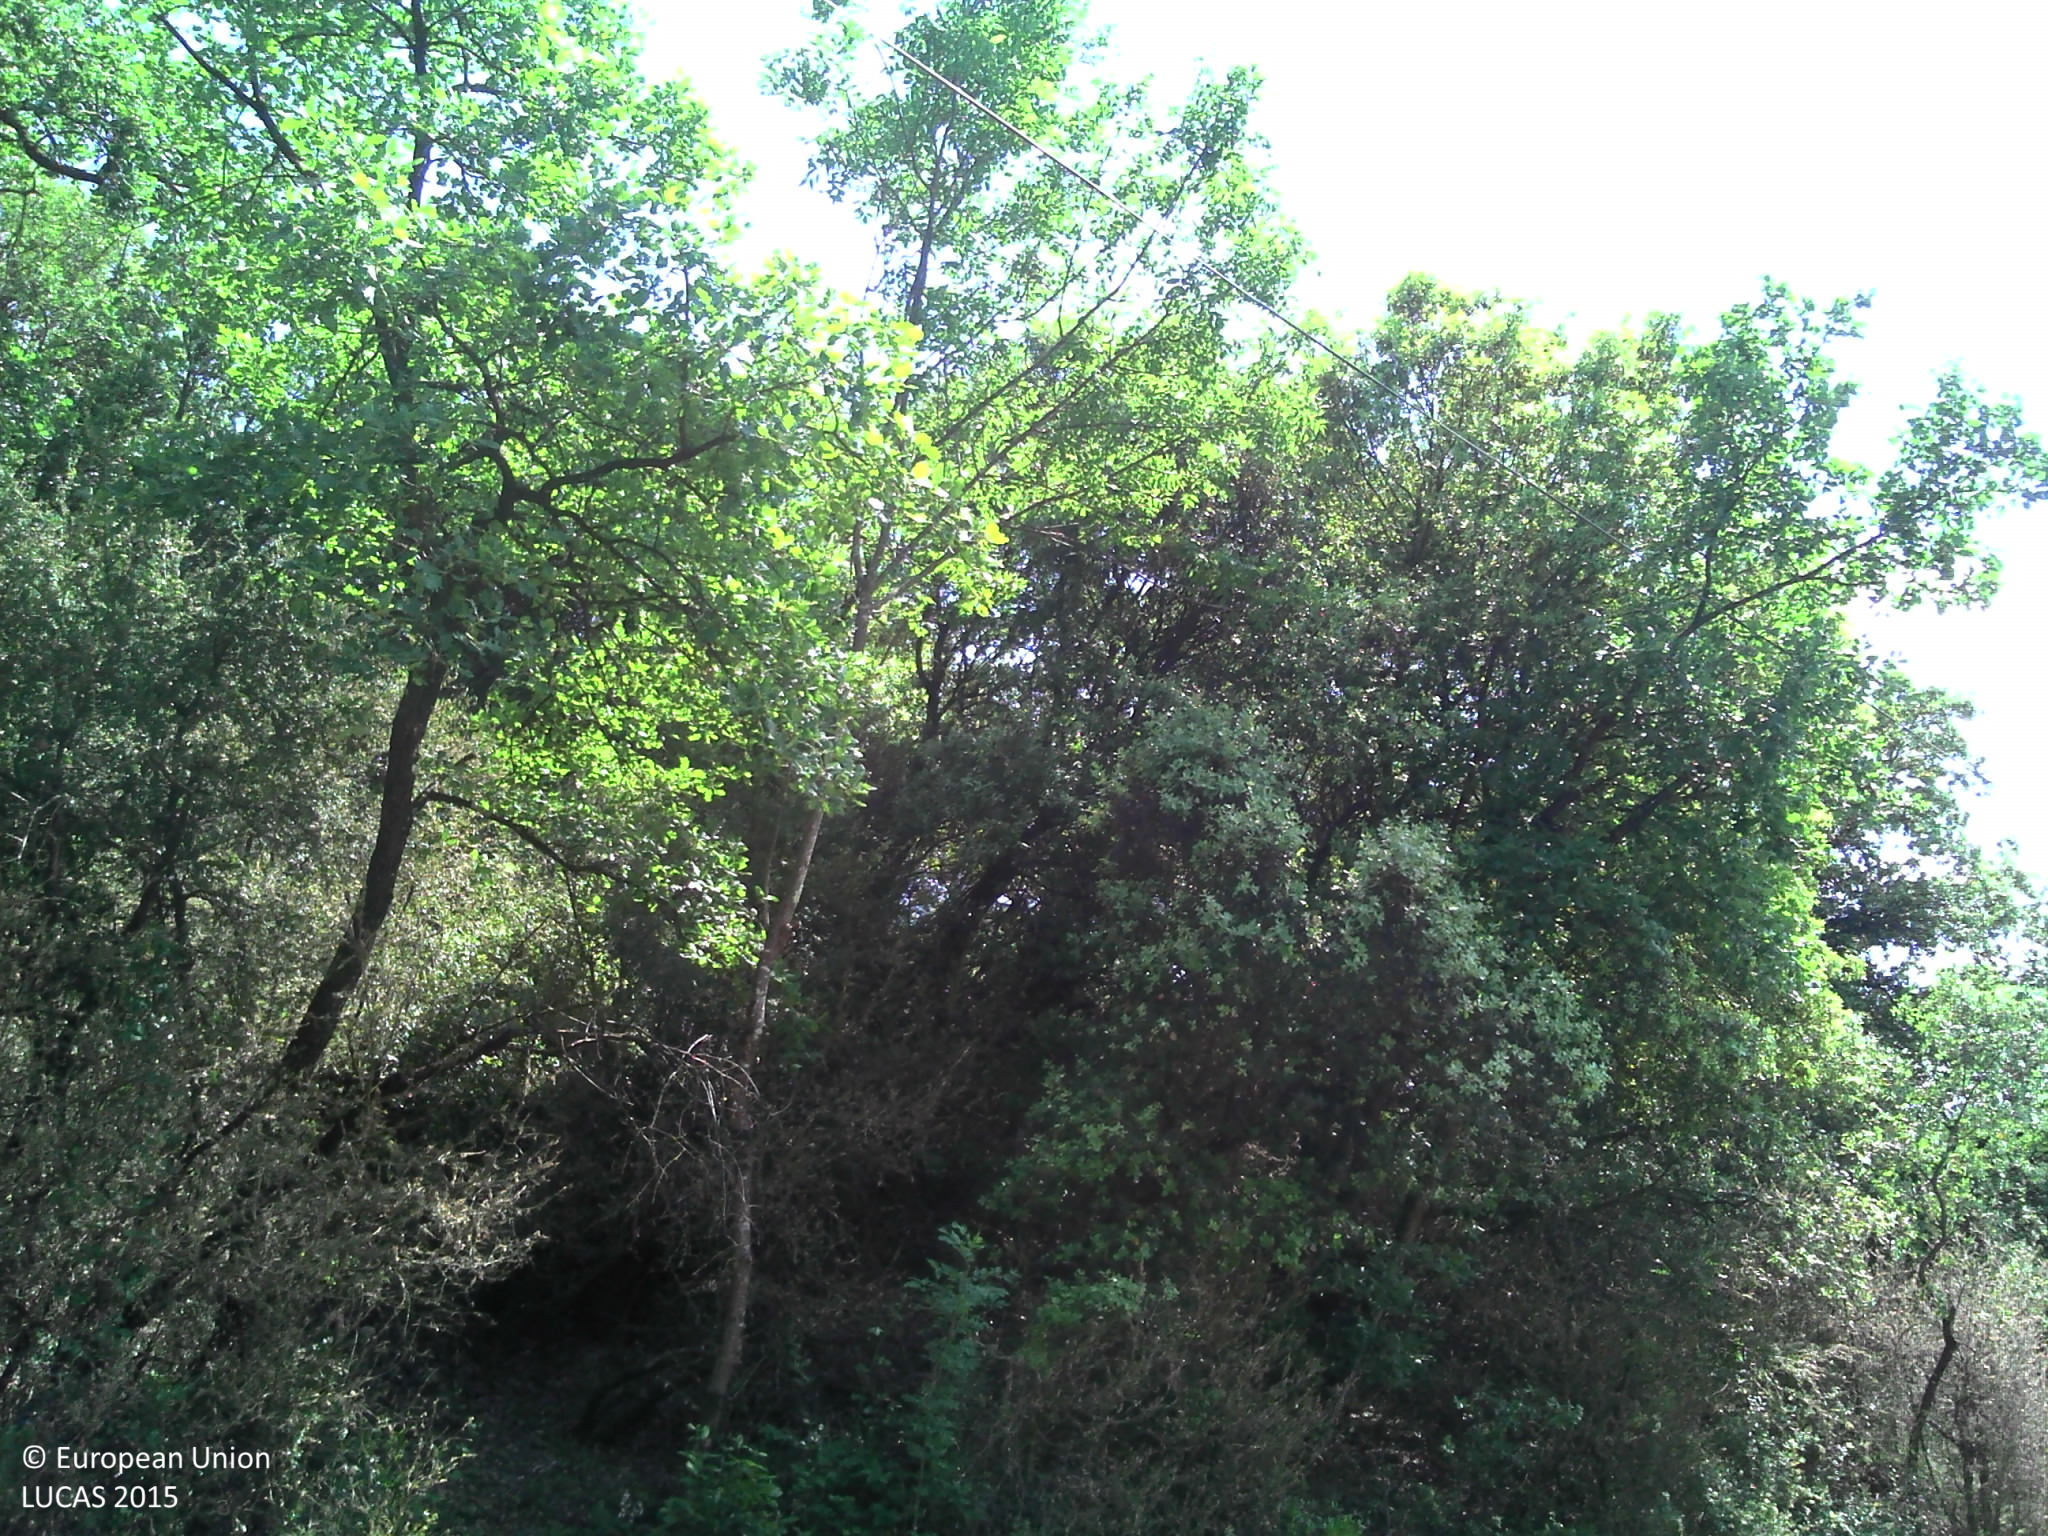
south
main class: Woodland
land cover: Broadleaved woodland
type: thermophilous deciduous forest
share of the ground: > 75 %
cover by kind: broadleaved forest trees 95 %, herbaceous plants 5 %
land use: Semi-natural and natural areas not in use
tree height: > 5 m
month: May
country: FR
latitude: 45.0029
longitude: 4.9183
